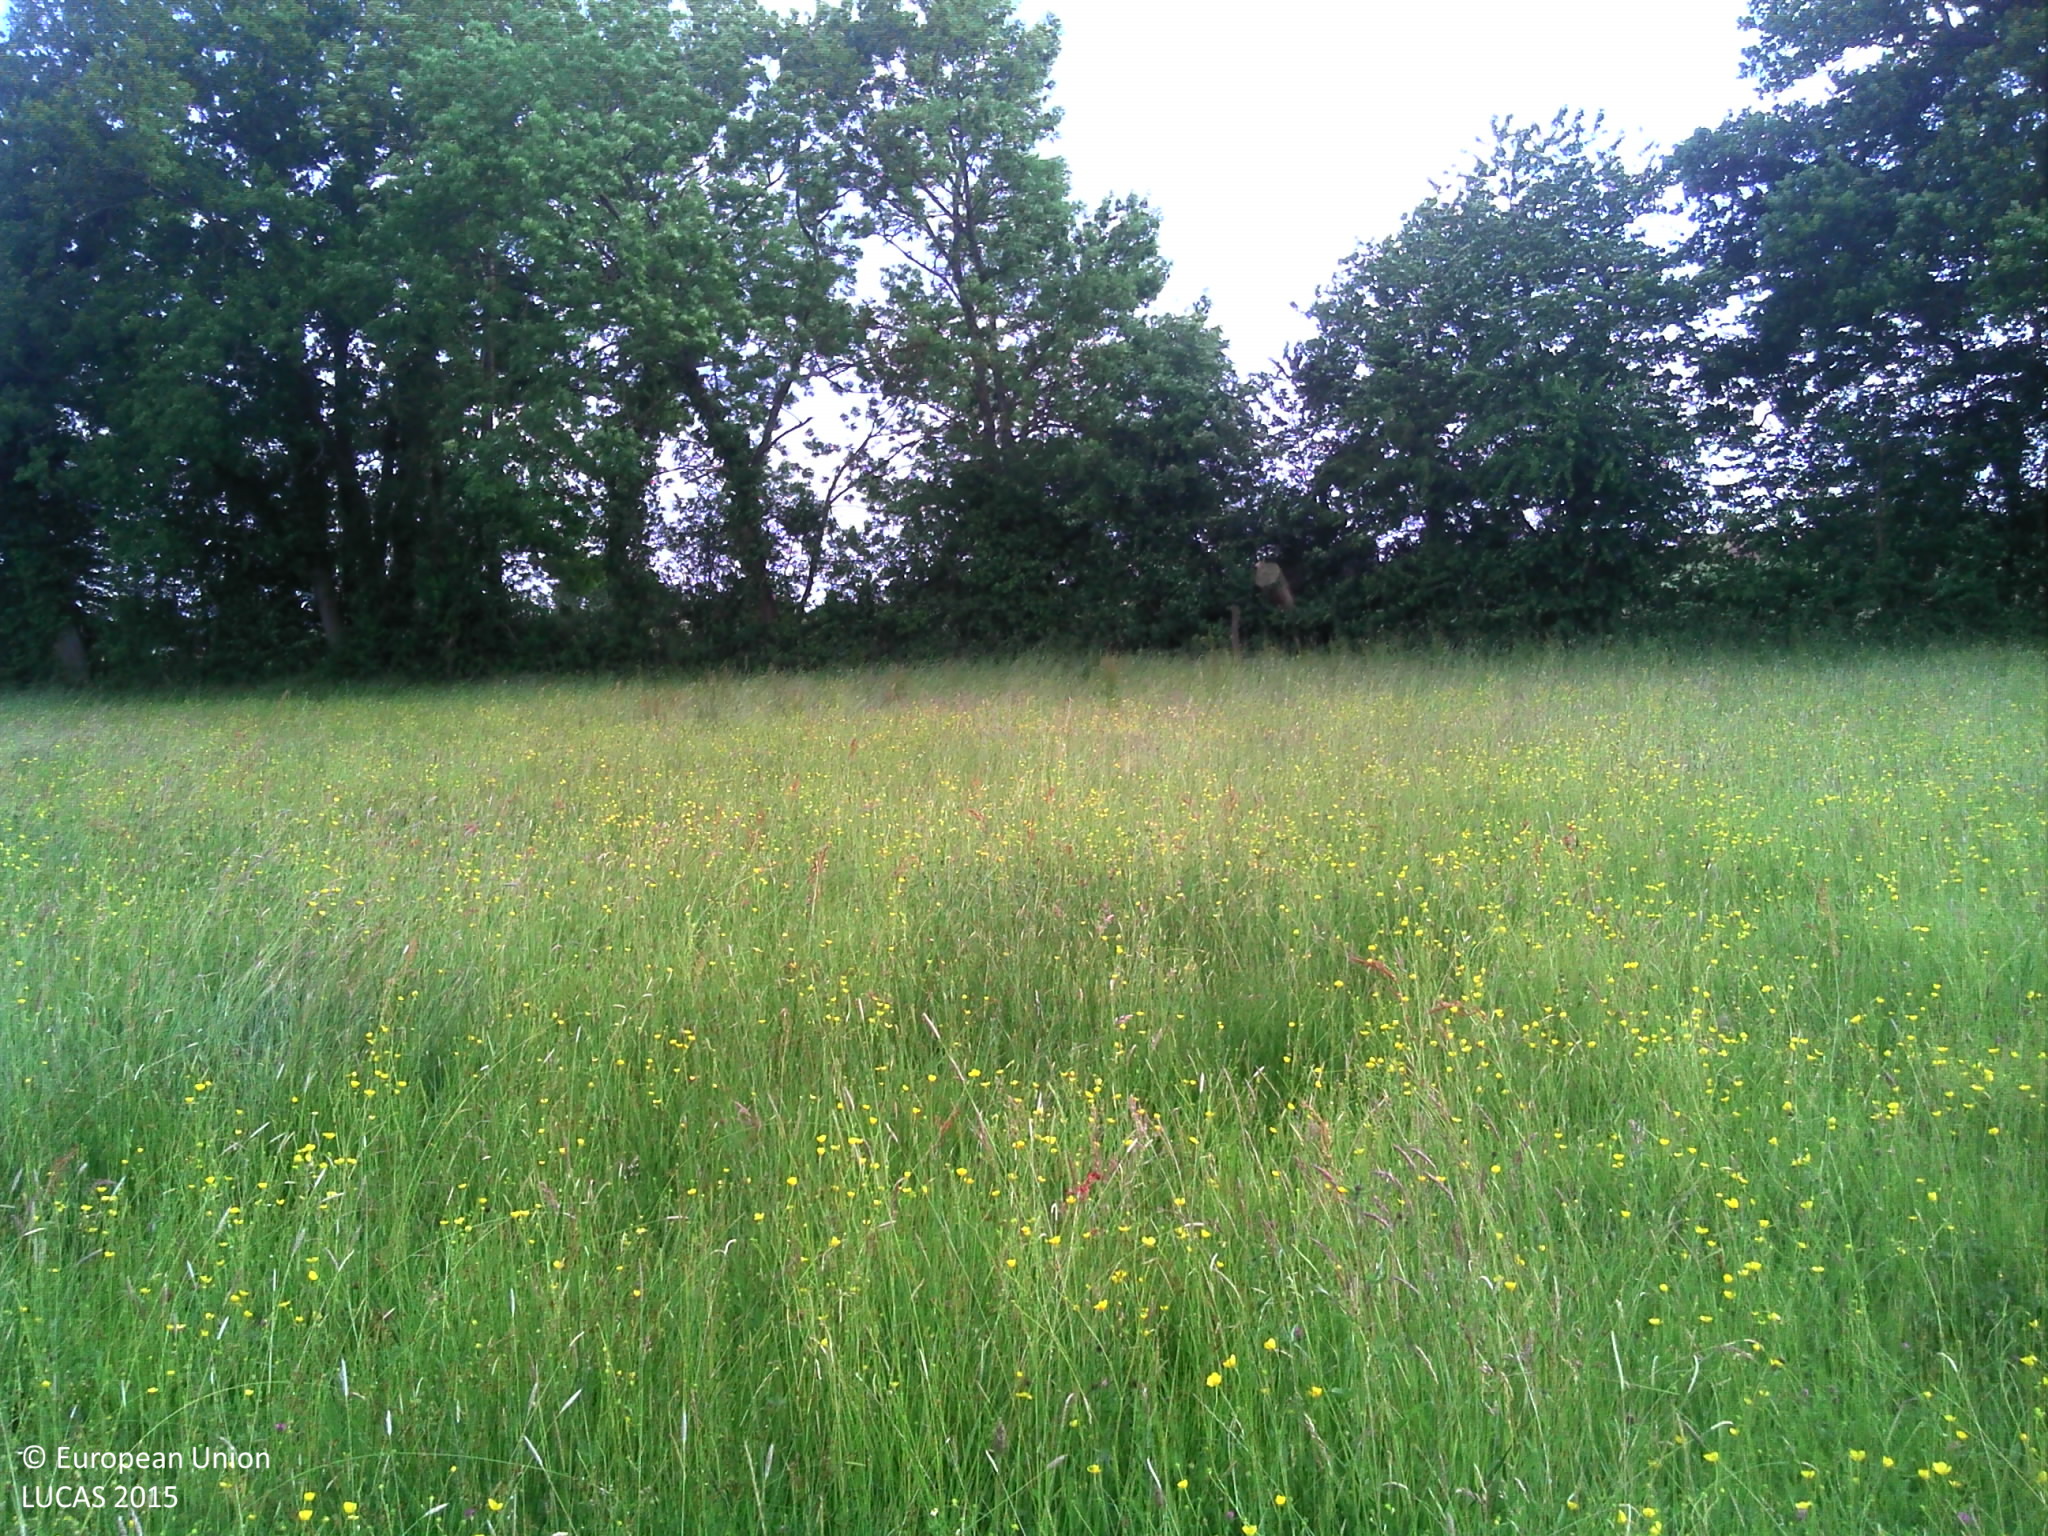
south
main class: Grassland
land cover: Grassland without tree/shrub cover
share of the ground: > 75 %
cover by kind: herbaceous plants 95 %
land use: Agriculture (excluding fallow land and kitchen gardens)
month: June
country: FR
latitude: 48.6448
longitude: 0.0765
